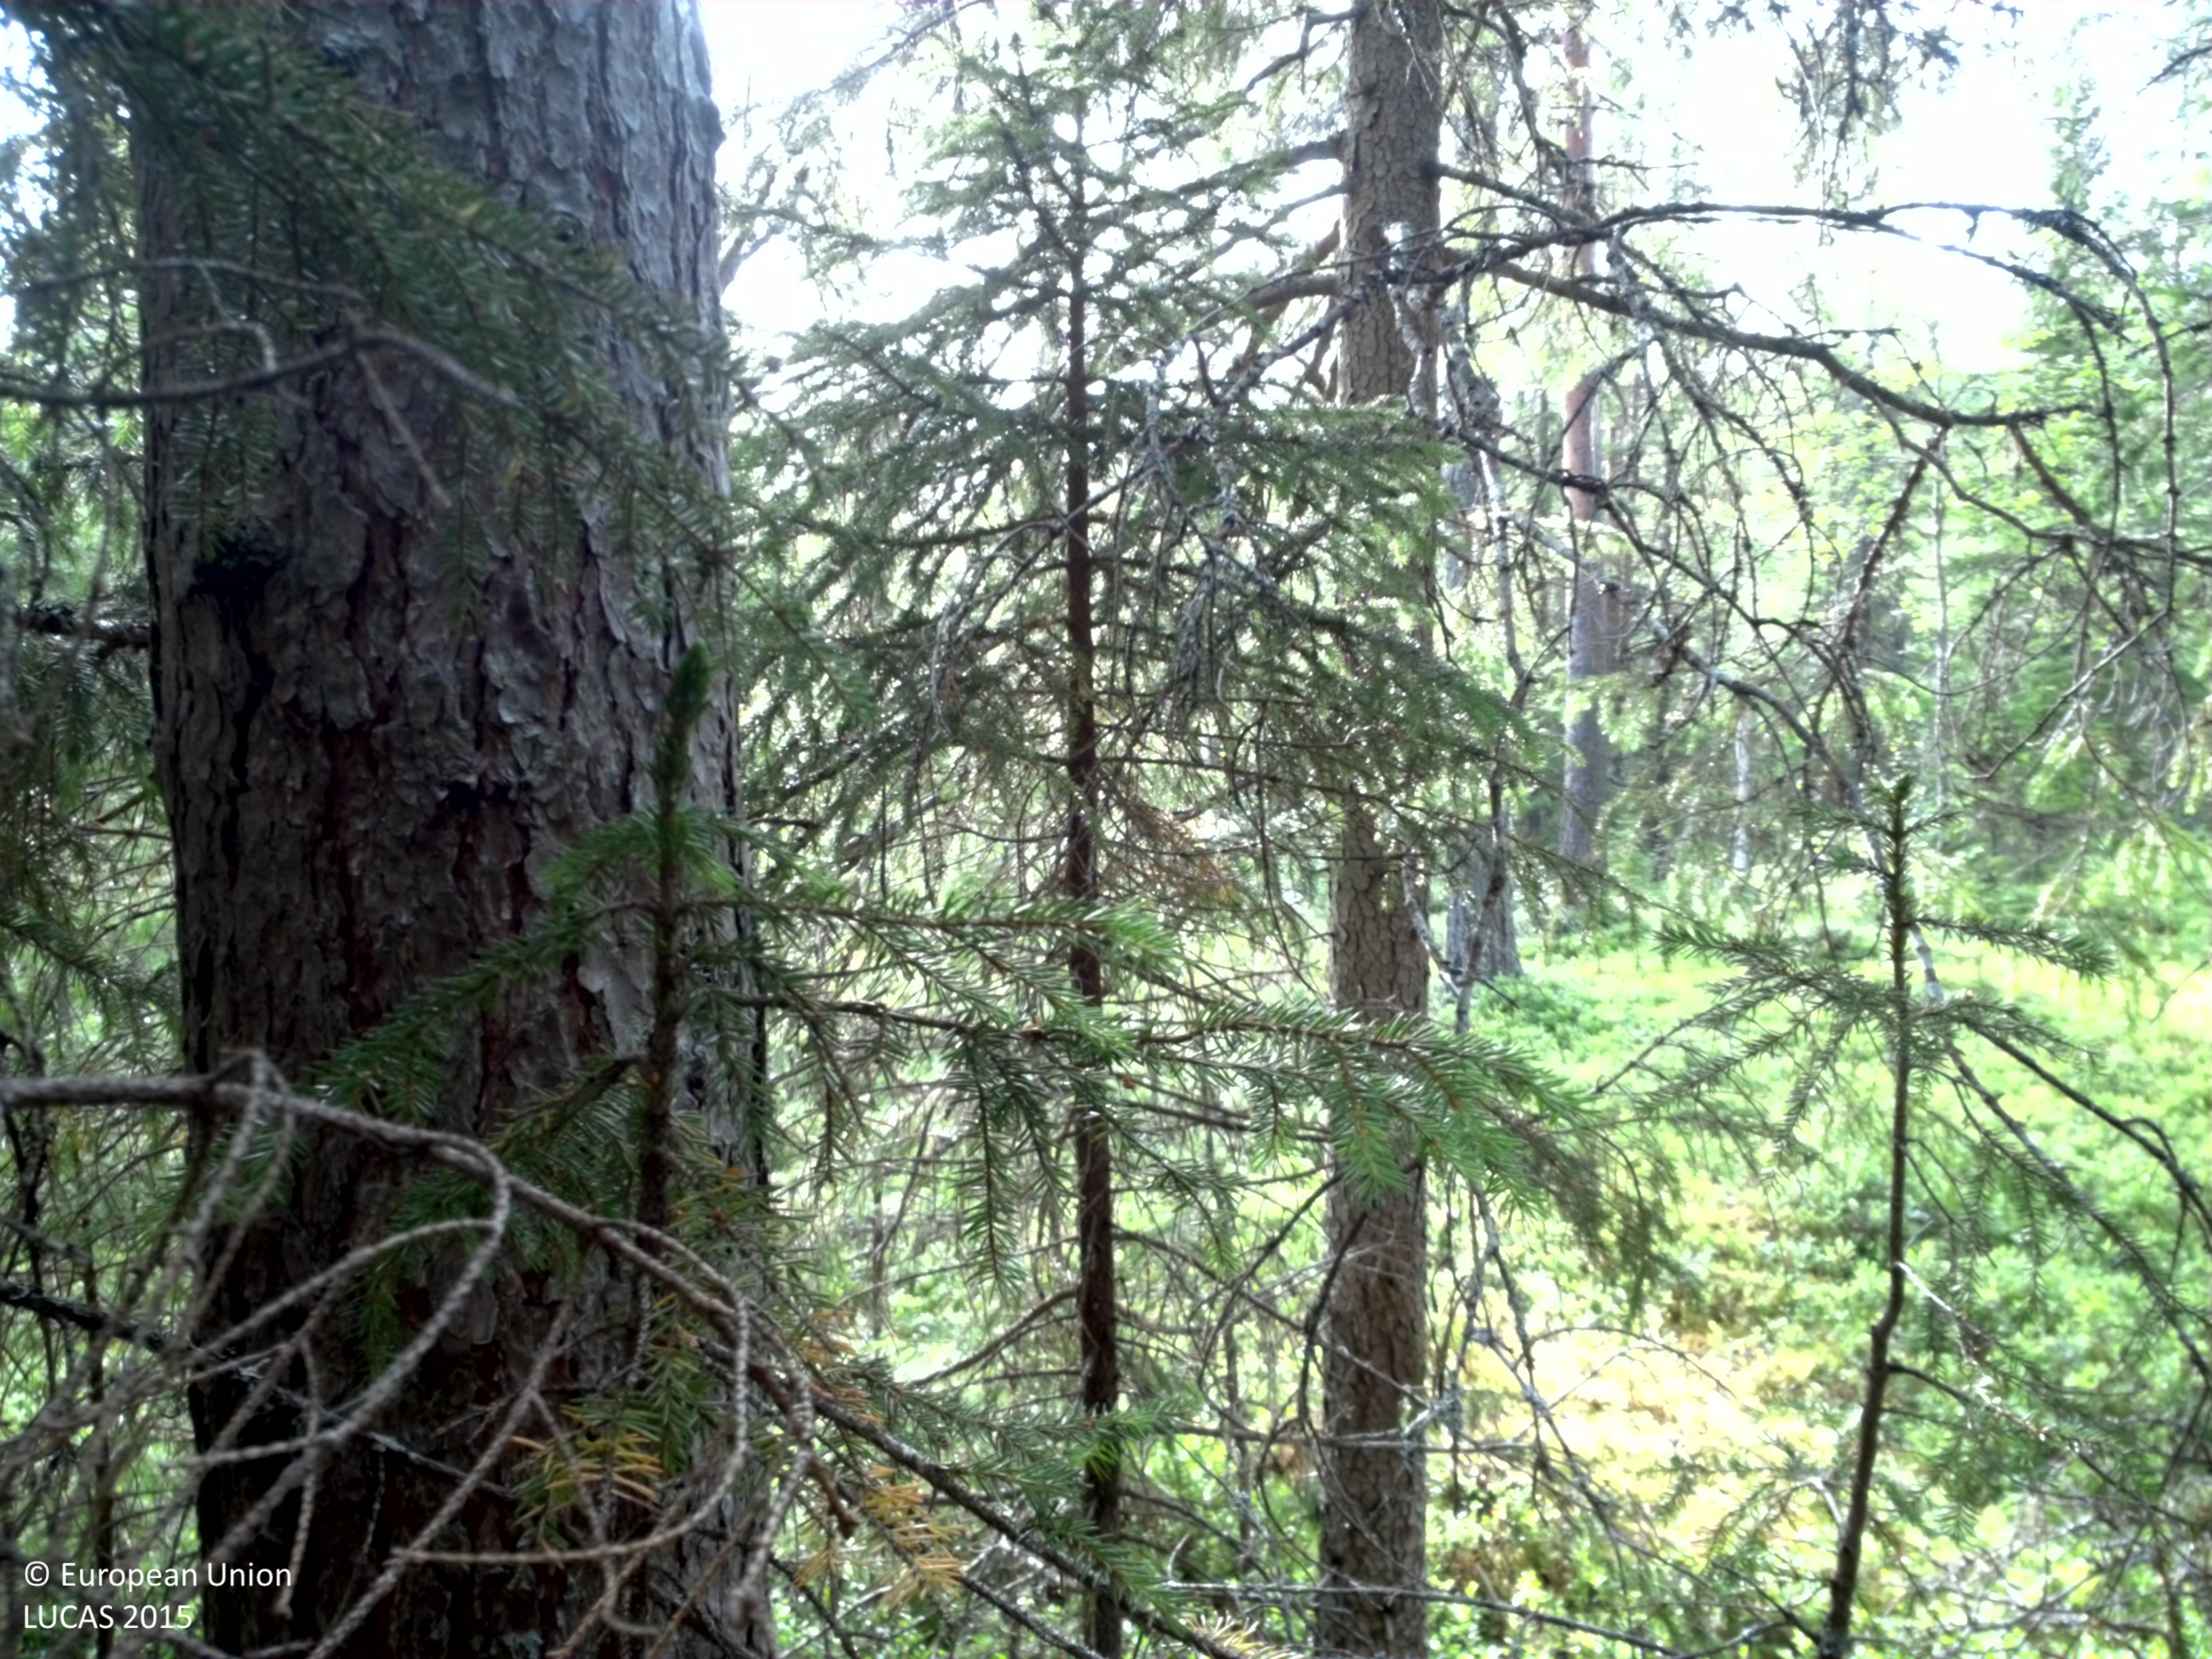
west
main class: Woodland
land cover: Other coniferous woodland
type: boreal forest
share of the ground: 50 - 75 %
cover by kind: coniferous forest trees 60 %, shrubs 35 %, lichens and mosses 5 %
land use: Forestry
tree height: > 5 m
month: August
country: SE
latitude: 64.8246
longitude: 16.0977
